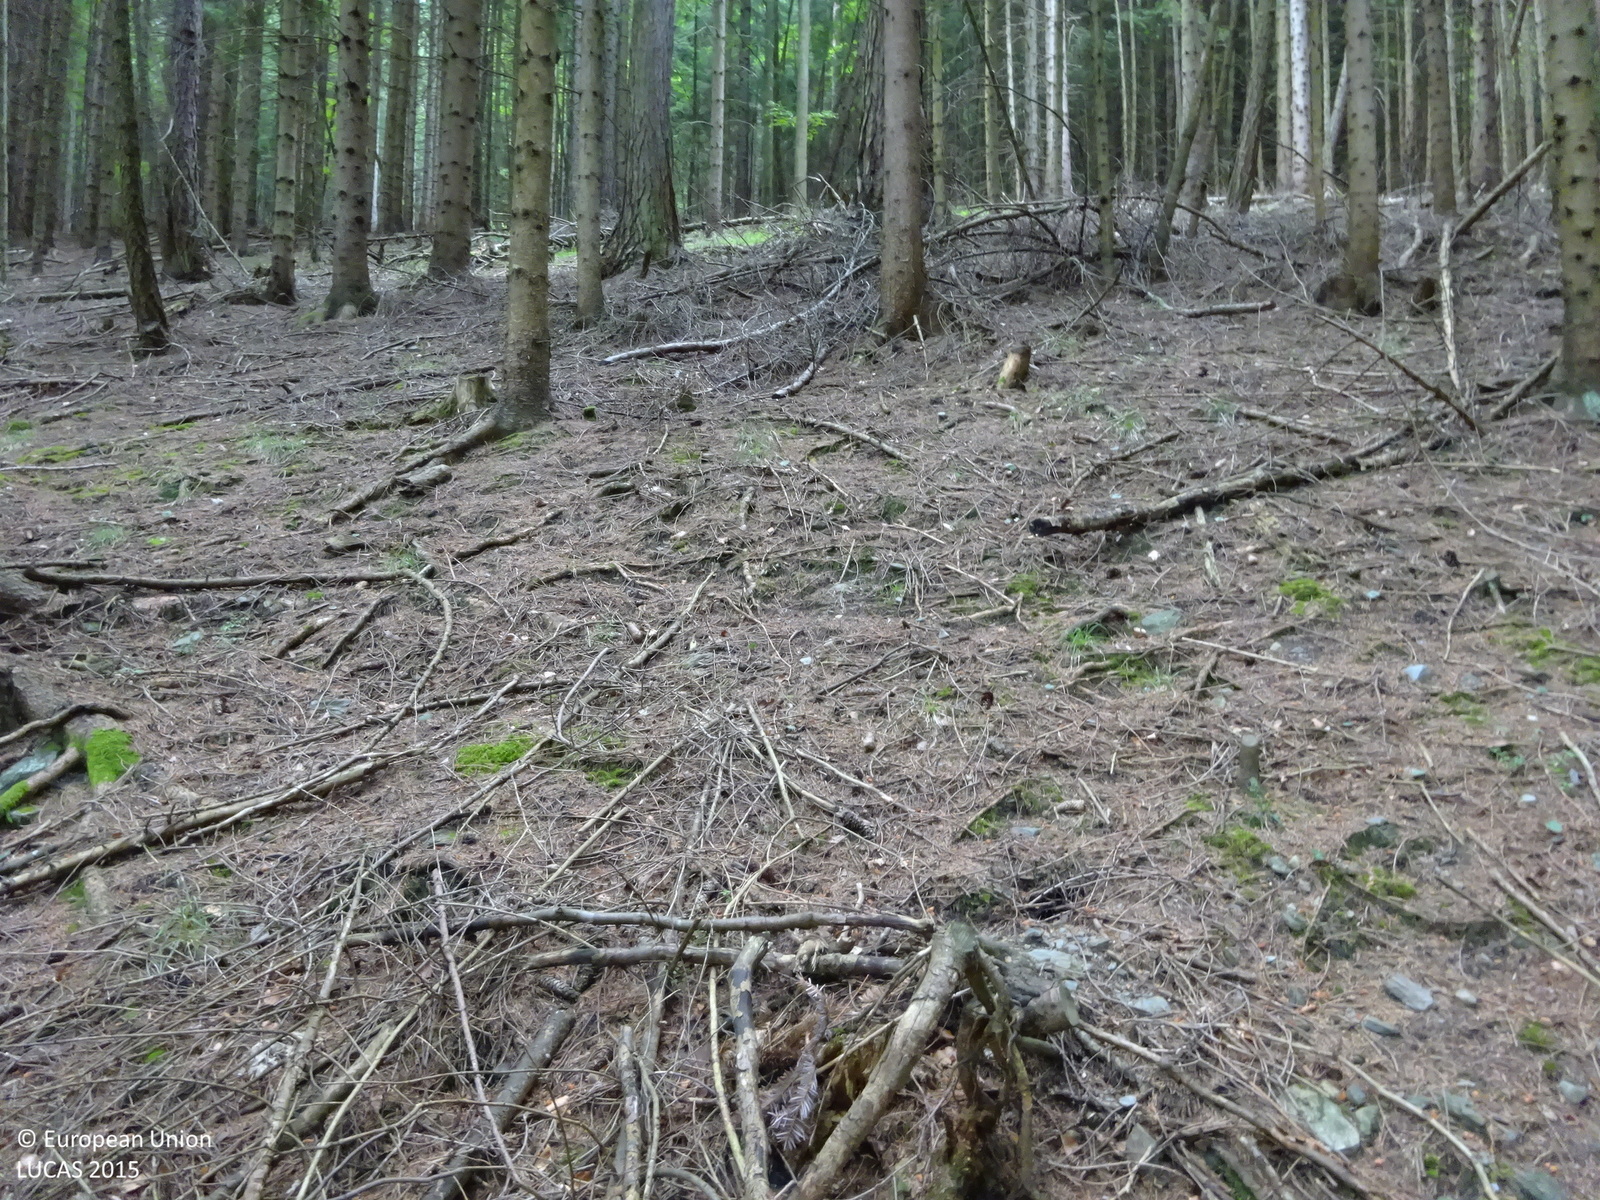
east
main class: Woodland
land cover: Spruce dominated coniferous woodland
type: alpine coniferous forest
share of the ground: > 75 %
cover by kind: coniferous forest trees 100 %
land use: Forestry
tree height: > 5 m
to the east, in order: Spruce dominated coniferous woodland; Tracks; Pine dominated mixed woodland; Tracks; Broadleaved woodland; Paved roads, cycling and walking lanes; Spruce dominated coniferous woodland; Tracks; Spruce dominated mixed woodland
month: July
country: AT
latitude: 47.1881
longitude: 15.4242
